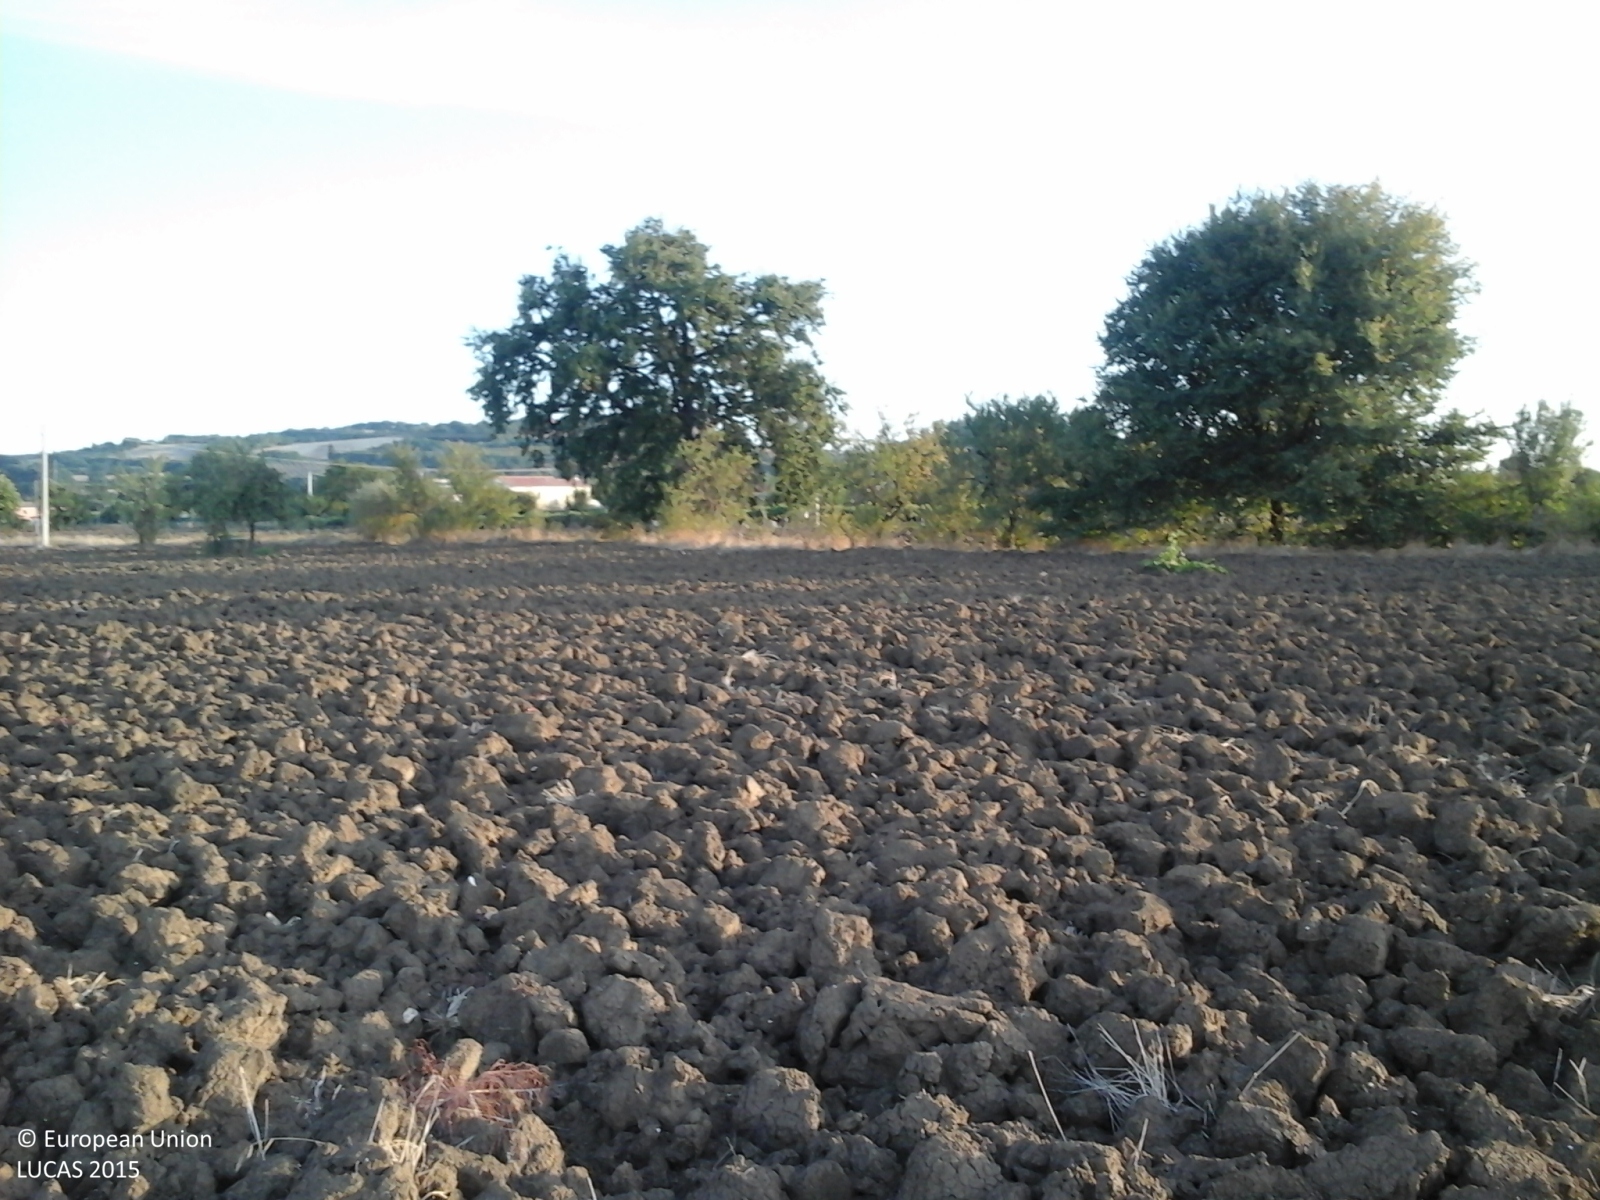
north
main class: Cropland
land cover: Oats
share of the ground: < 10 %
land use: Agriculture (excluding fallow land and kitchen gardens)
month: September
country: IT
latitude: 43.7848
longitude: 12.9628
